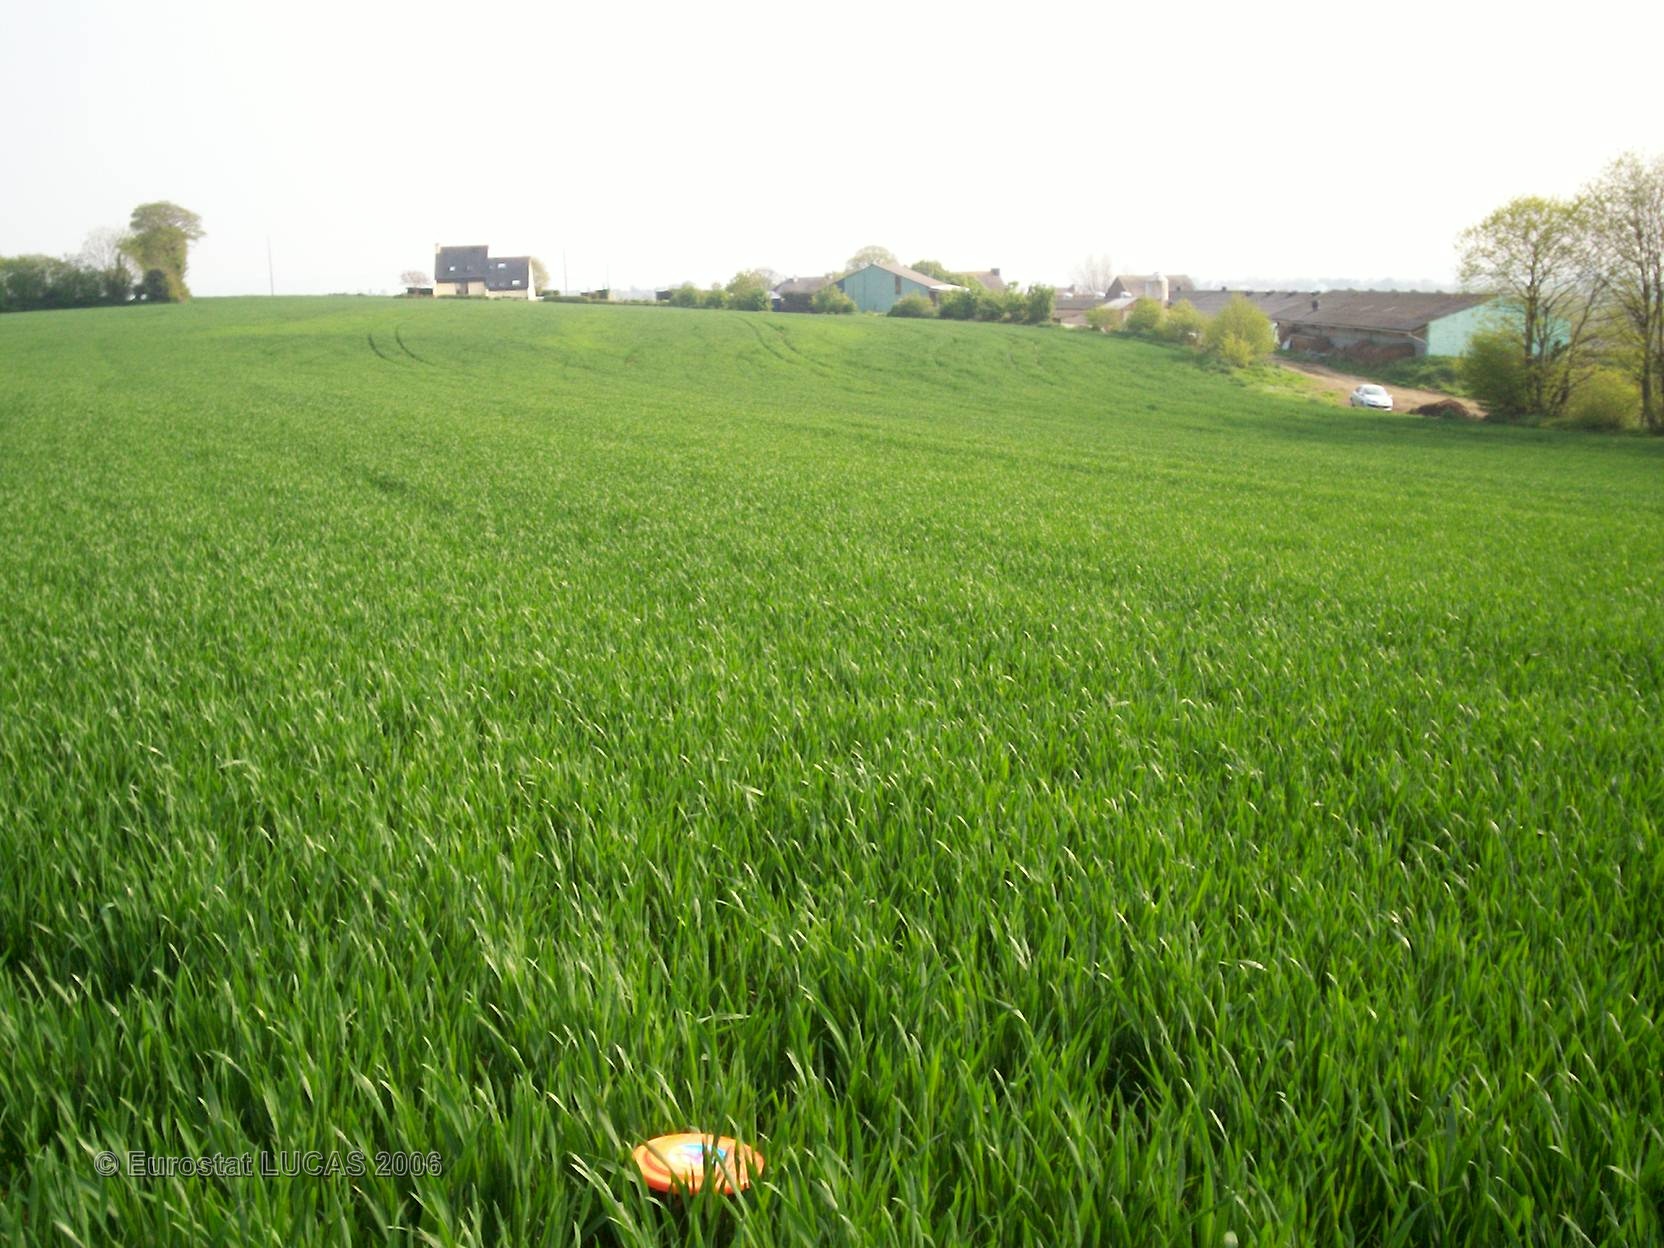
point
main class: Cropland
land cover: Common wheat
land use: Agriculture (excluding fallow land and kitchen gardens)
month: May
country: FR
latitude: 48.2415
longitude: -3.9697
